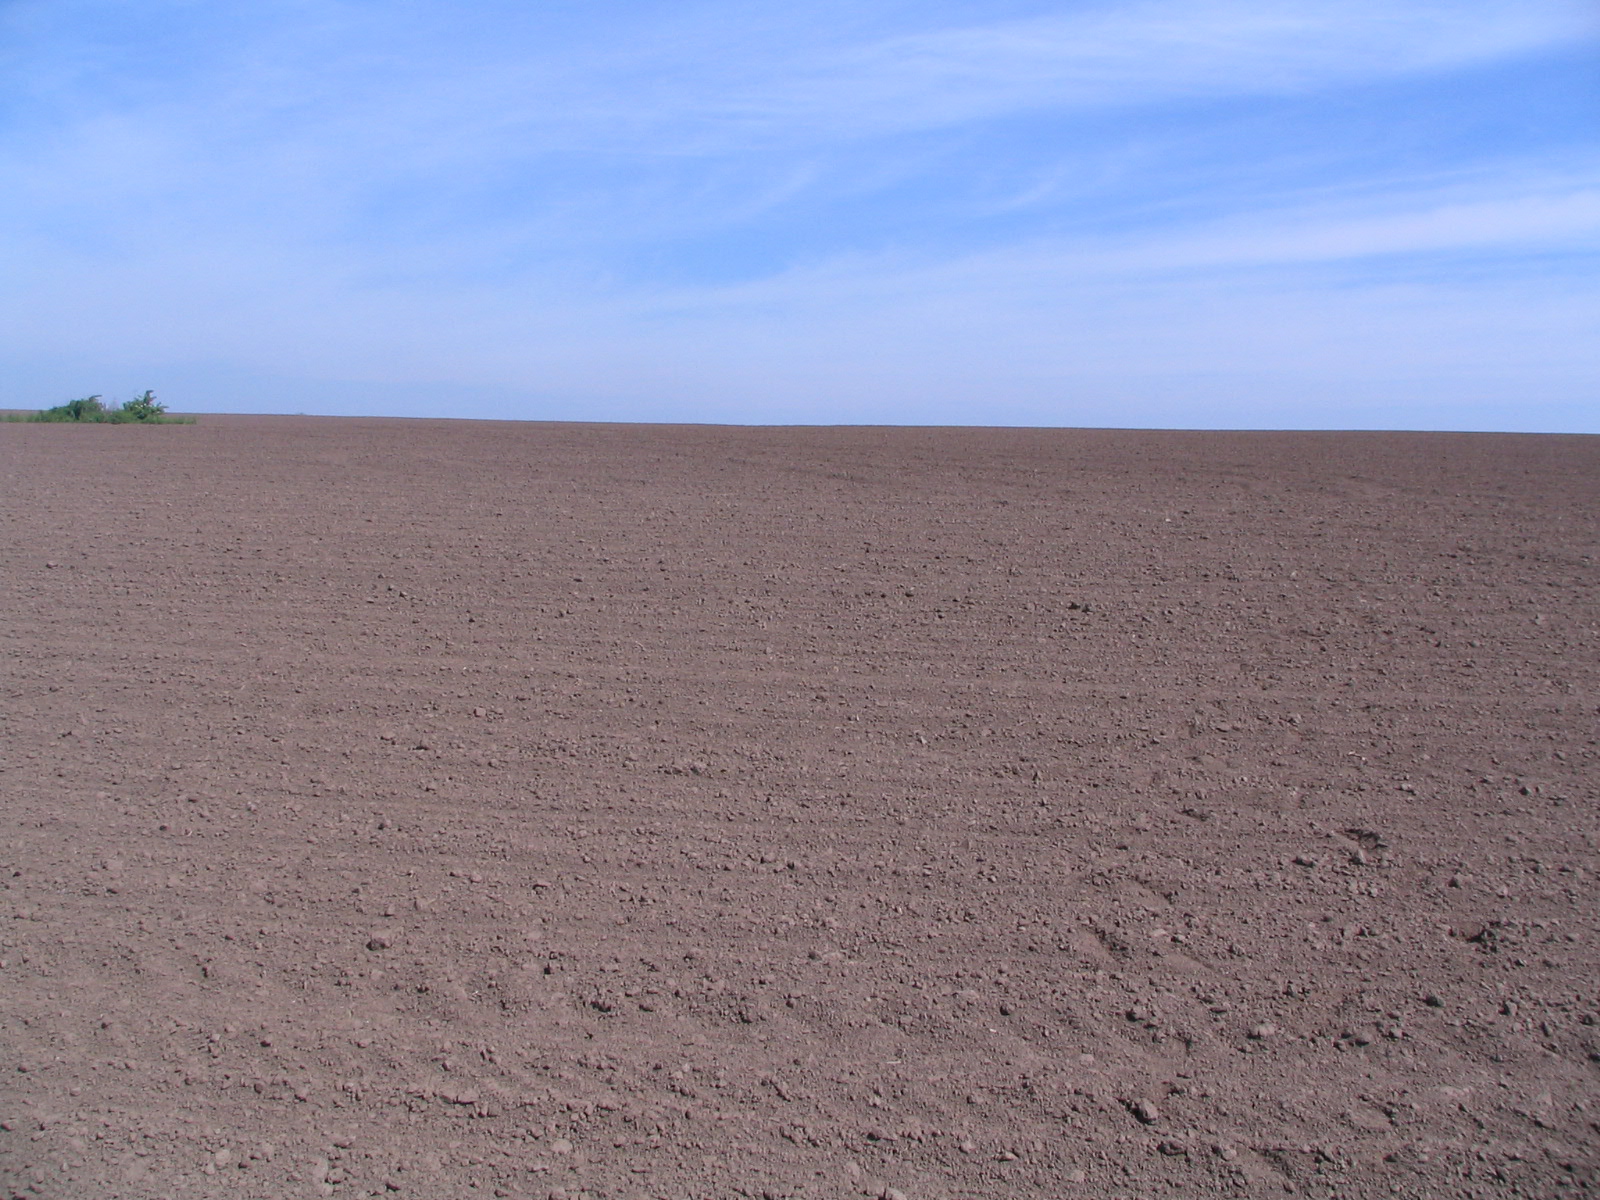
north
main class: Cropland
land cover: Maize
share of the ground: < 10 %
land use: Agriculture (excluding fallow land and kitchen gardens)
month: May
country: BG
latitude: 43.7181
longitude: 23.9179
